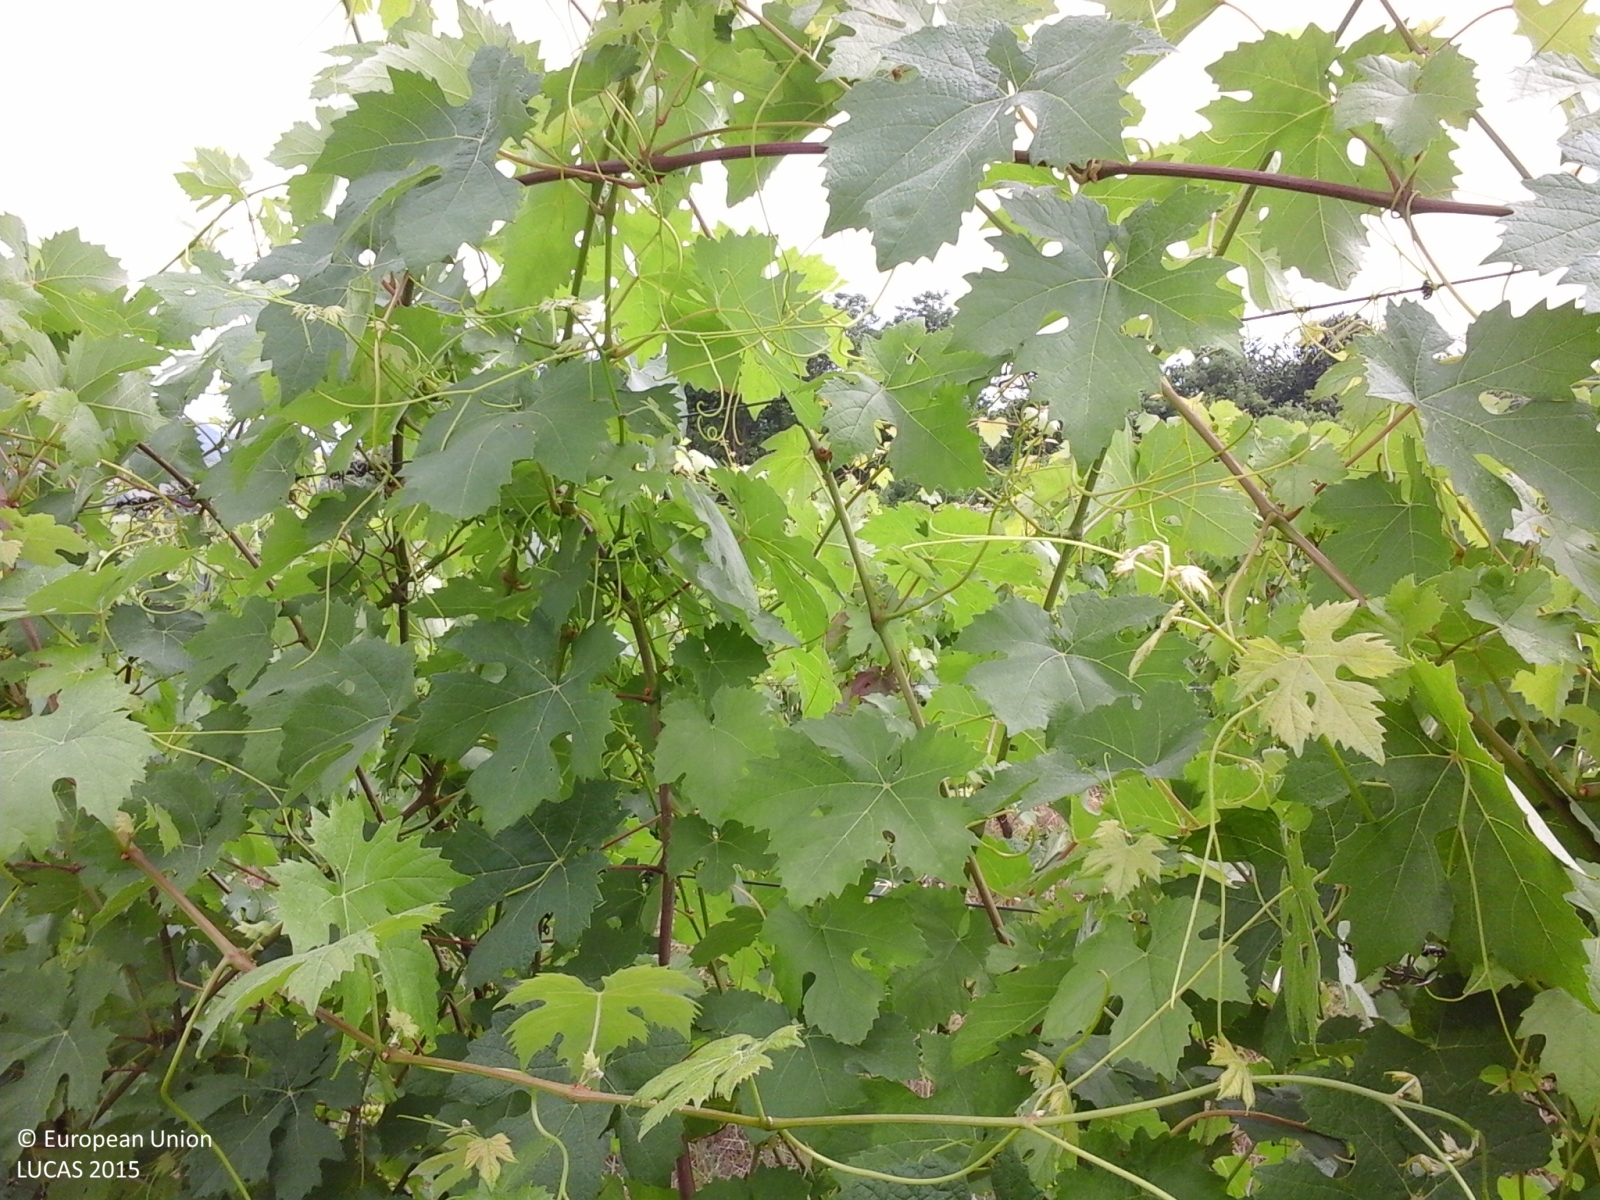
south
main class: Cropland
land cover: Vineyards
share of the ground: 10 - 25 %
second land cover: Grassland without tree/shrub cover
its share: > 75 %
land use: Agriculture (excluding fallow land and kitchen gardens)
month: June
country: IT
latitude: 44.8554
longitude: 9.8611
